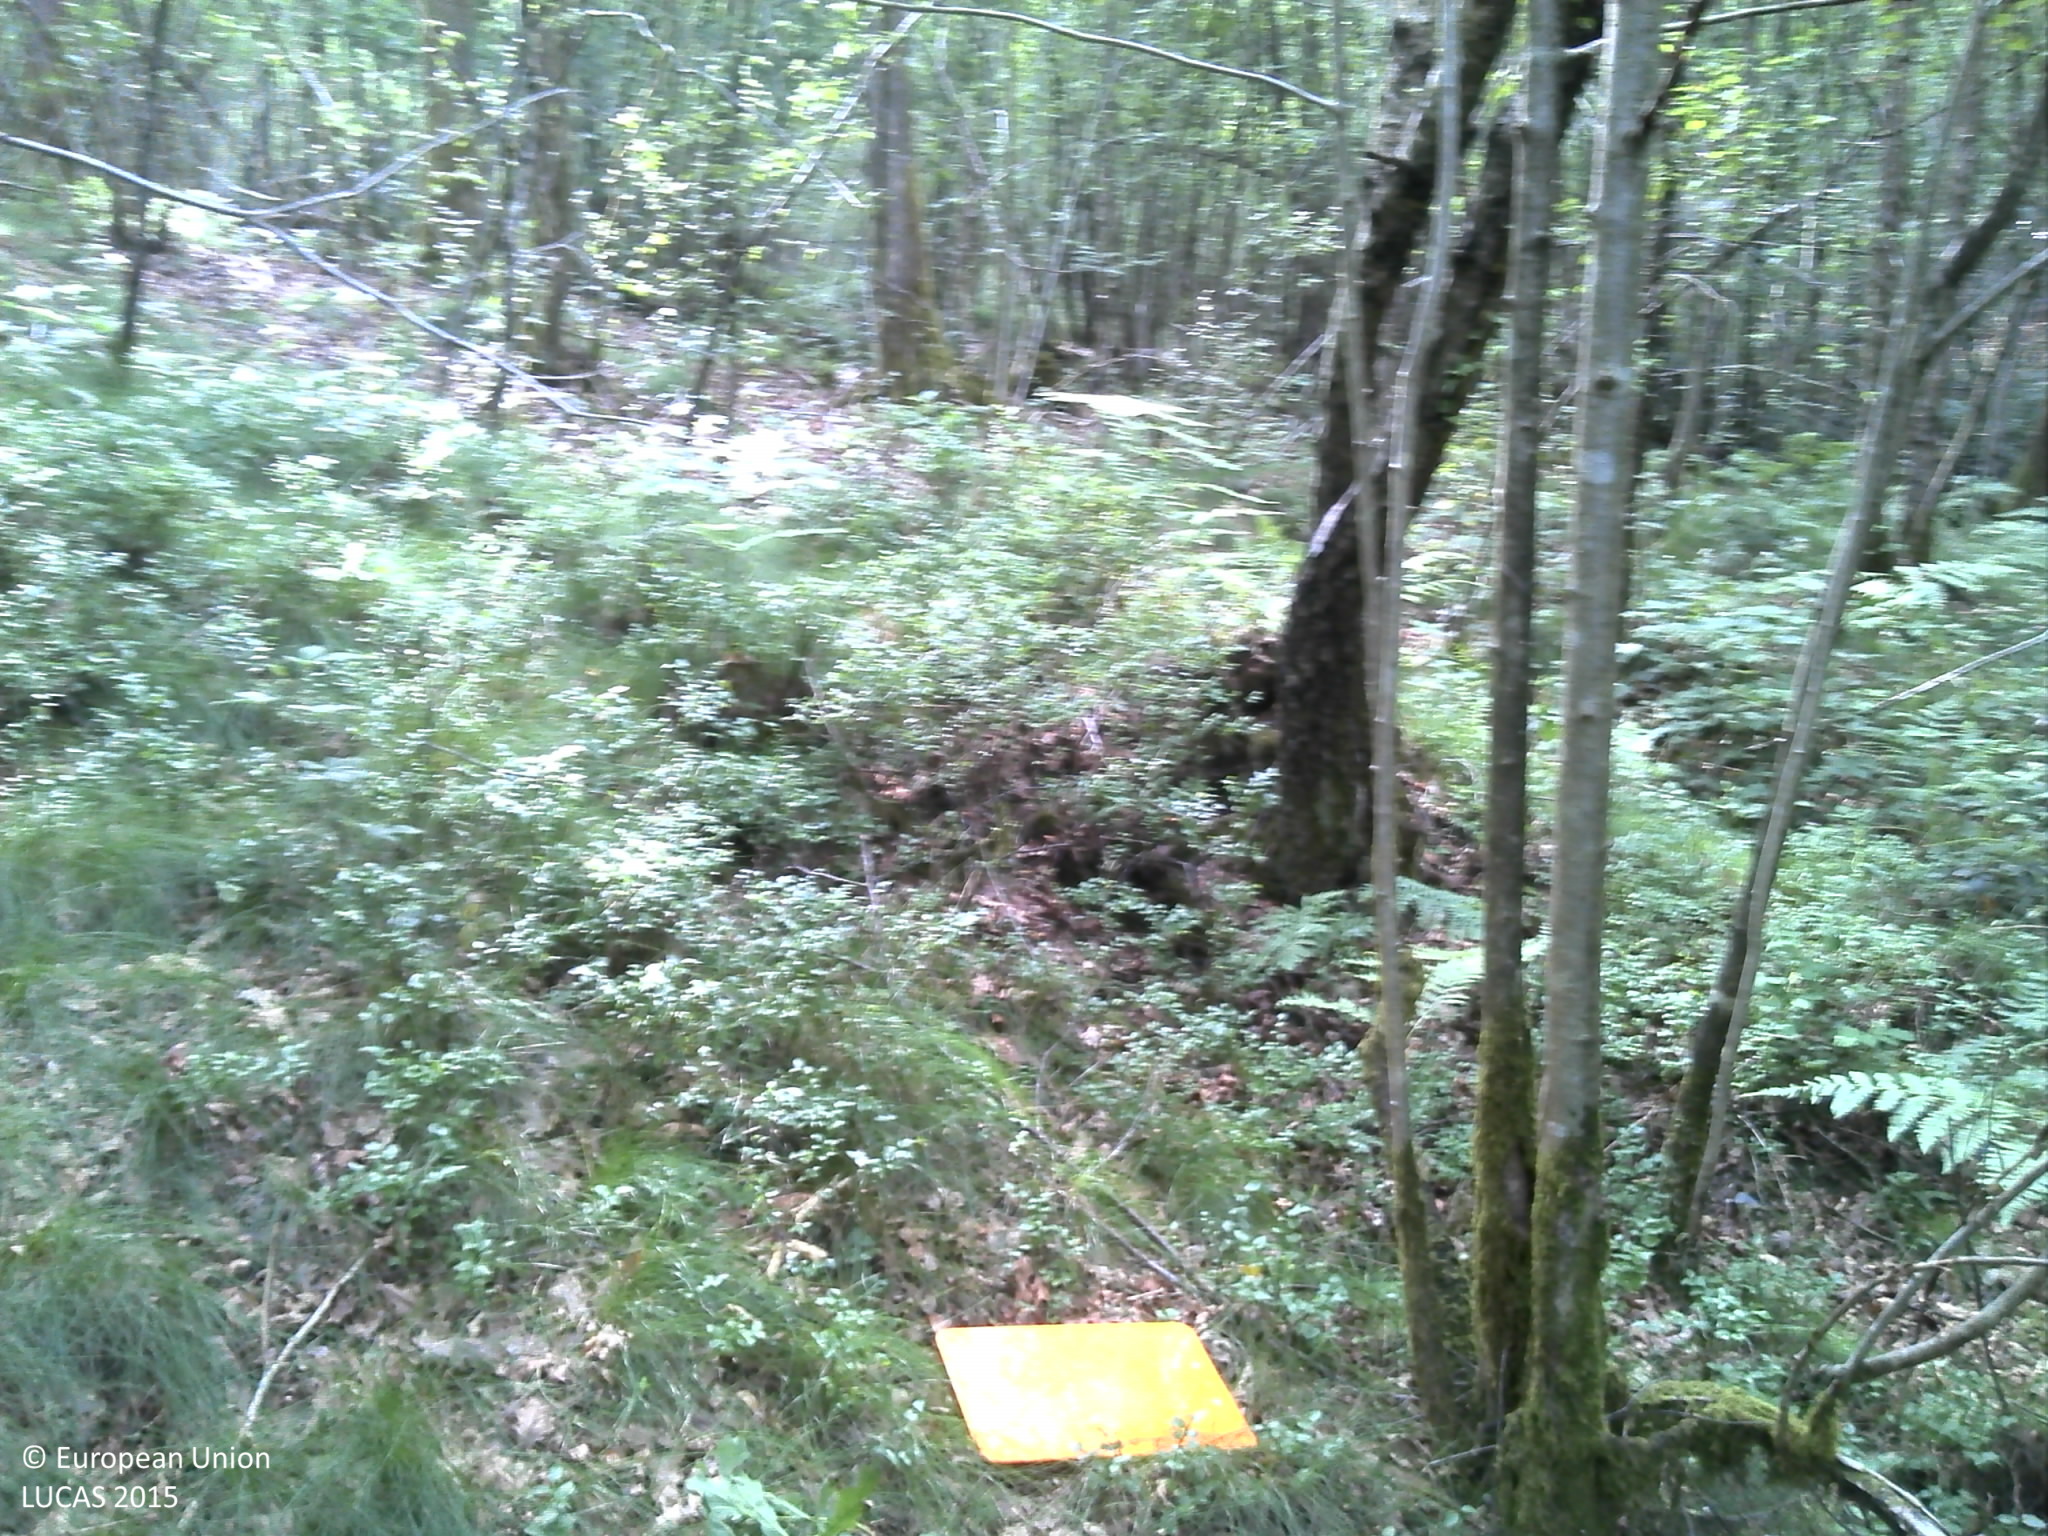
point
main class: Woodland
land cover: Broadleaved woodland
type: acidophilous oak and oak-birch forest
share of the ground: 50 - 75 %
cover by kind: broadleaved forest trees 75 %, herbaceous plants 15 %, lichens and mosses 5 %, consolidated bare surface 5 %
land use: Forestry
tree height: > 5 m
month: July
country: FR
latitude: 49.8805
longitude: 4.6944
